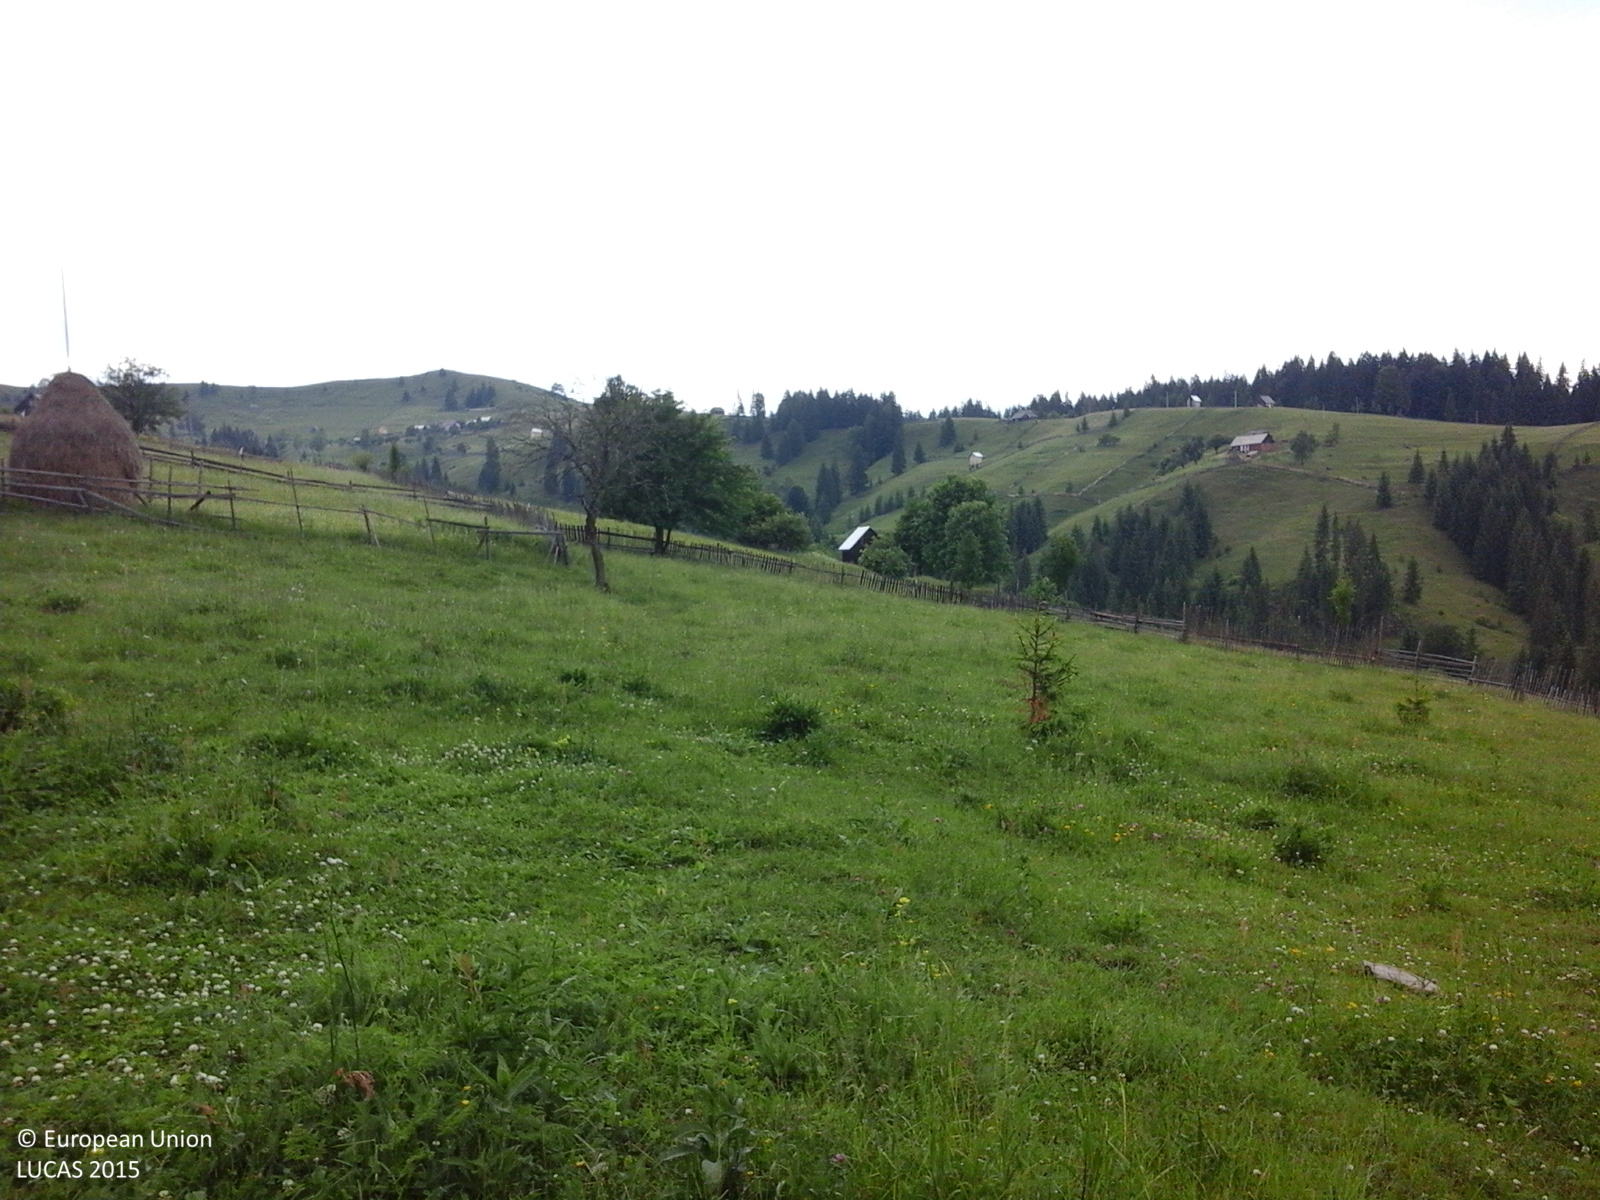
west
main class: Grassland
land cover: Grassland without tree/shrub cover
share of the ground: > 75 %
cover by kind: herbaceous plants 100 %
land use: Agriculture (excluding fallow land and kitchen gardens)
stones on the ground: < 10 %
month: June
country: RO
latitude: 47.8497
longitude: 25.2539
